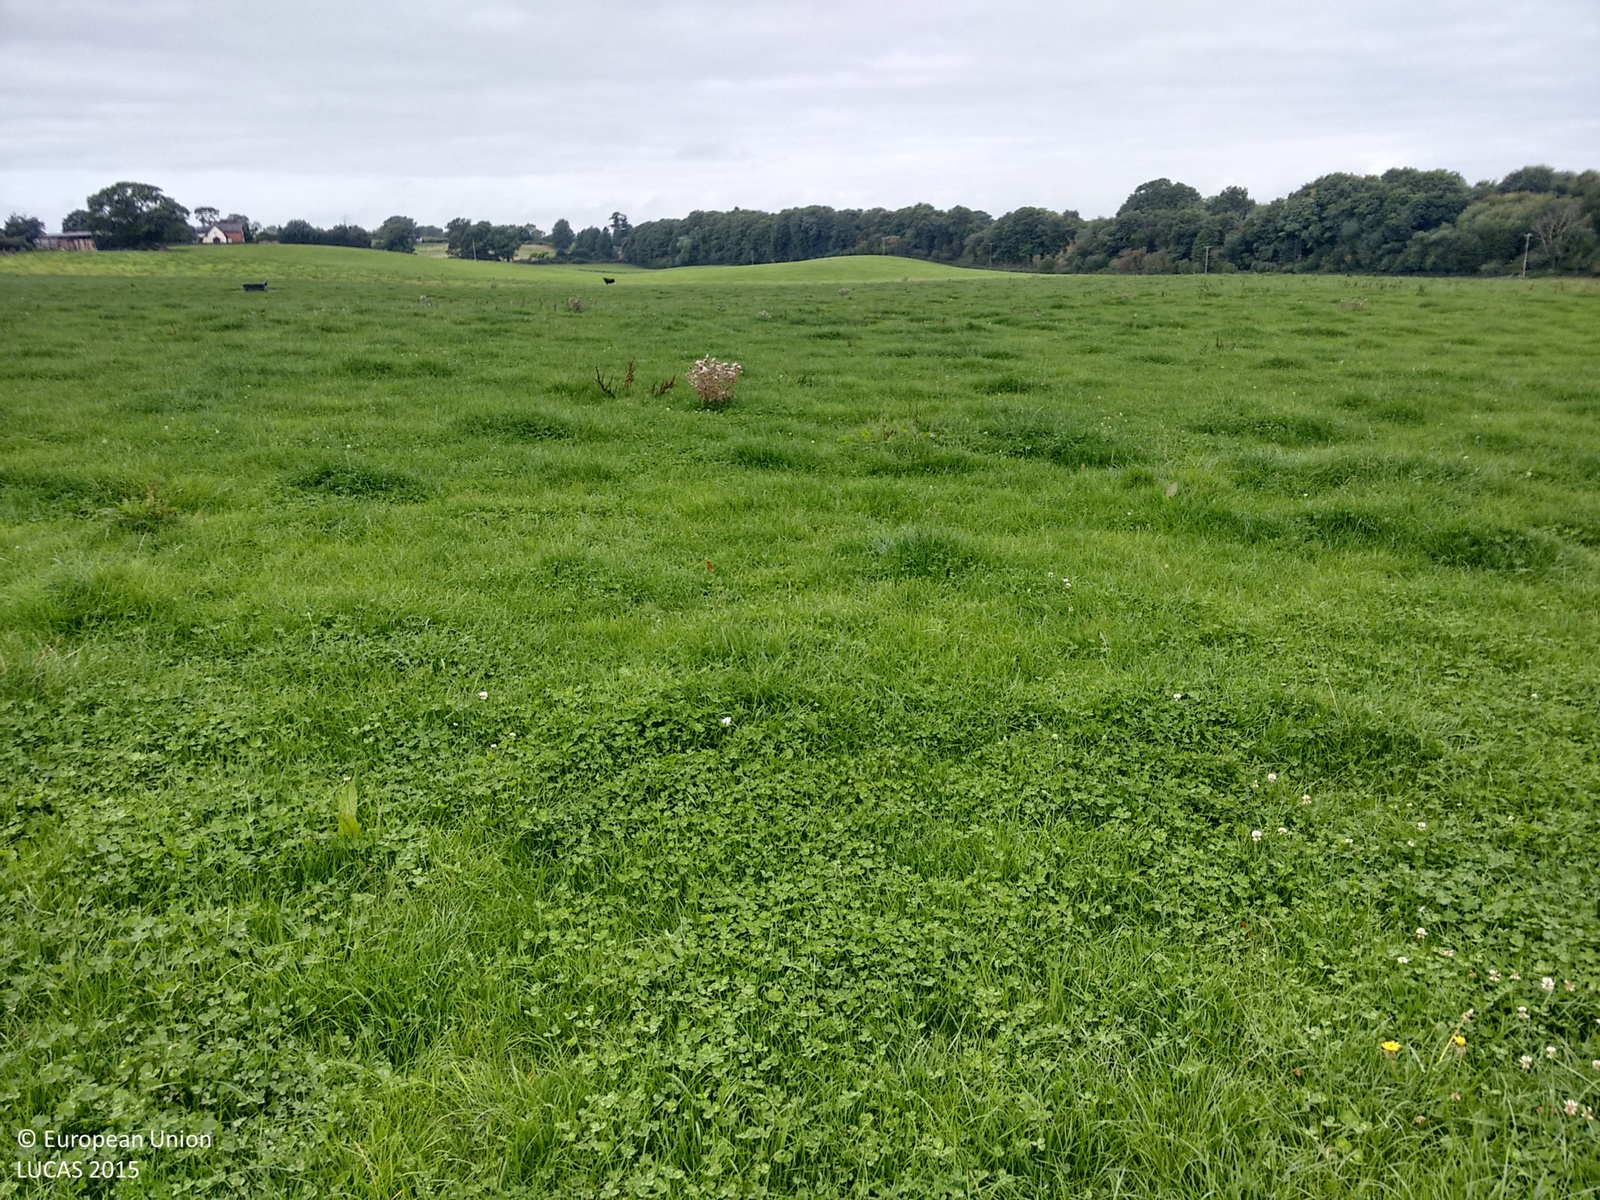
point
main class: Grassland
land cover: Grassland without tree/shrub cover
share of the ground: > 75 %
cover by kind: herbaceous plants 100 %
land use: Agriculture (excluding fallow land and kitchen gardens)
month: September
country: GB
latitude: 52.9049
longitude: -2.9343
